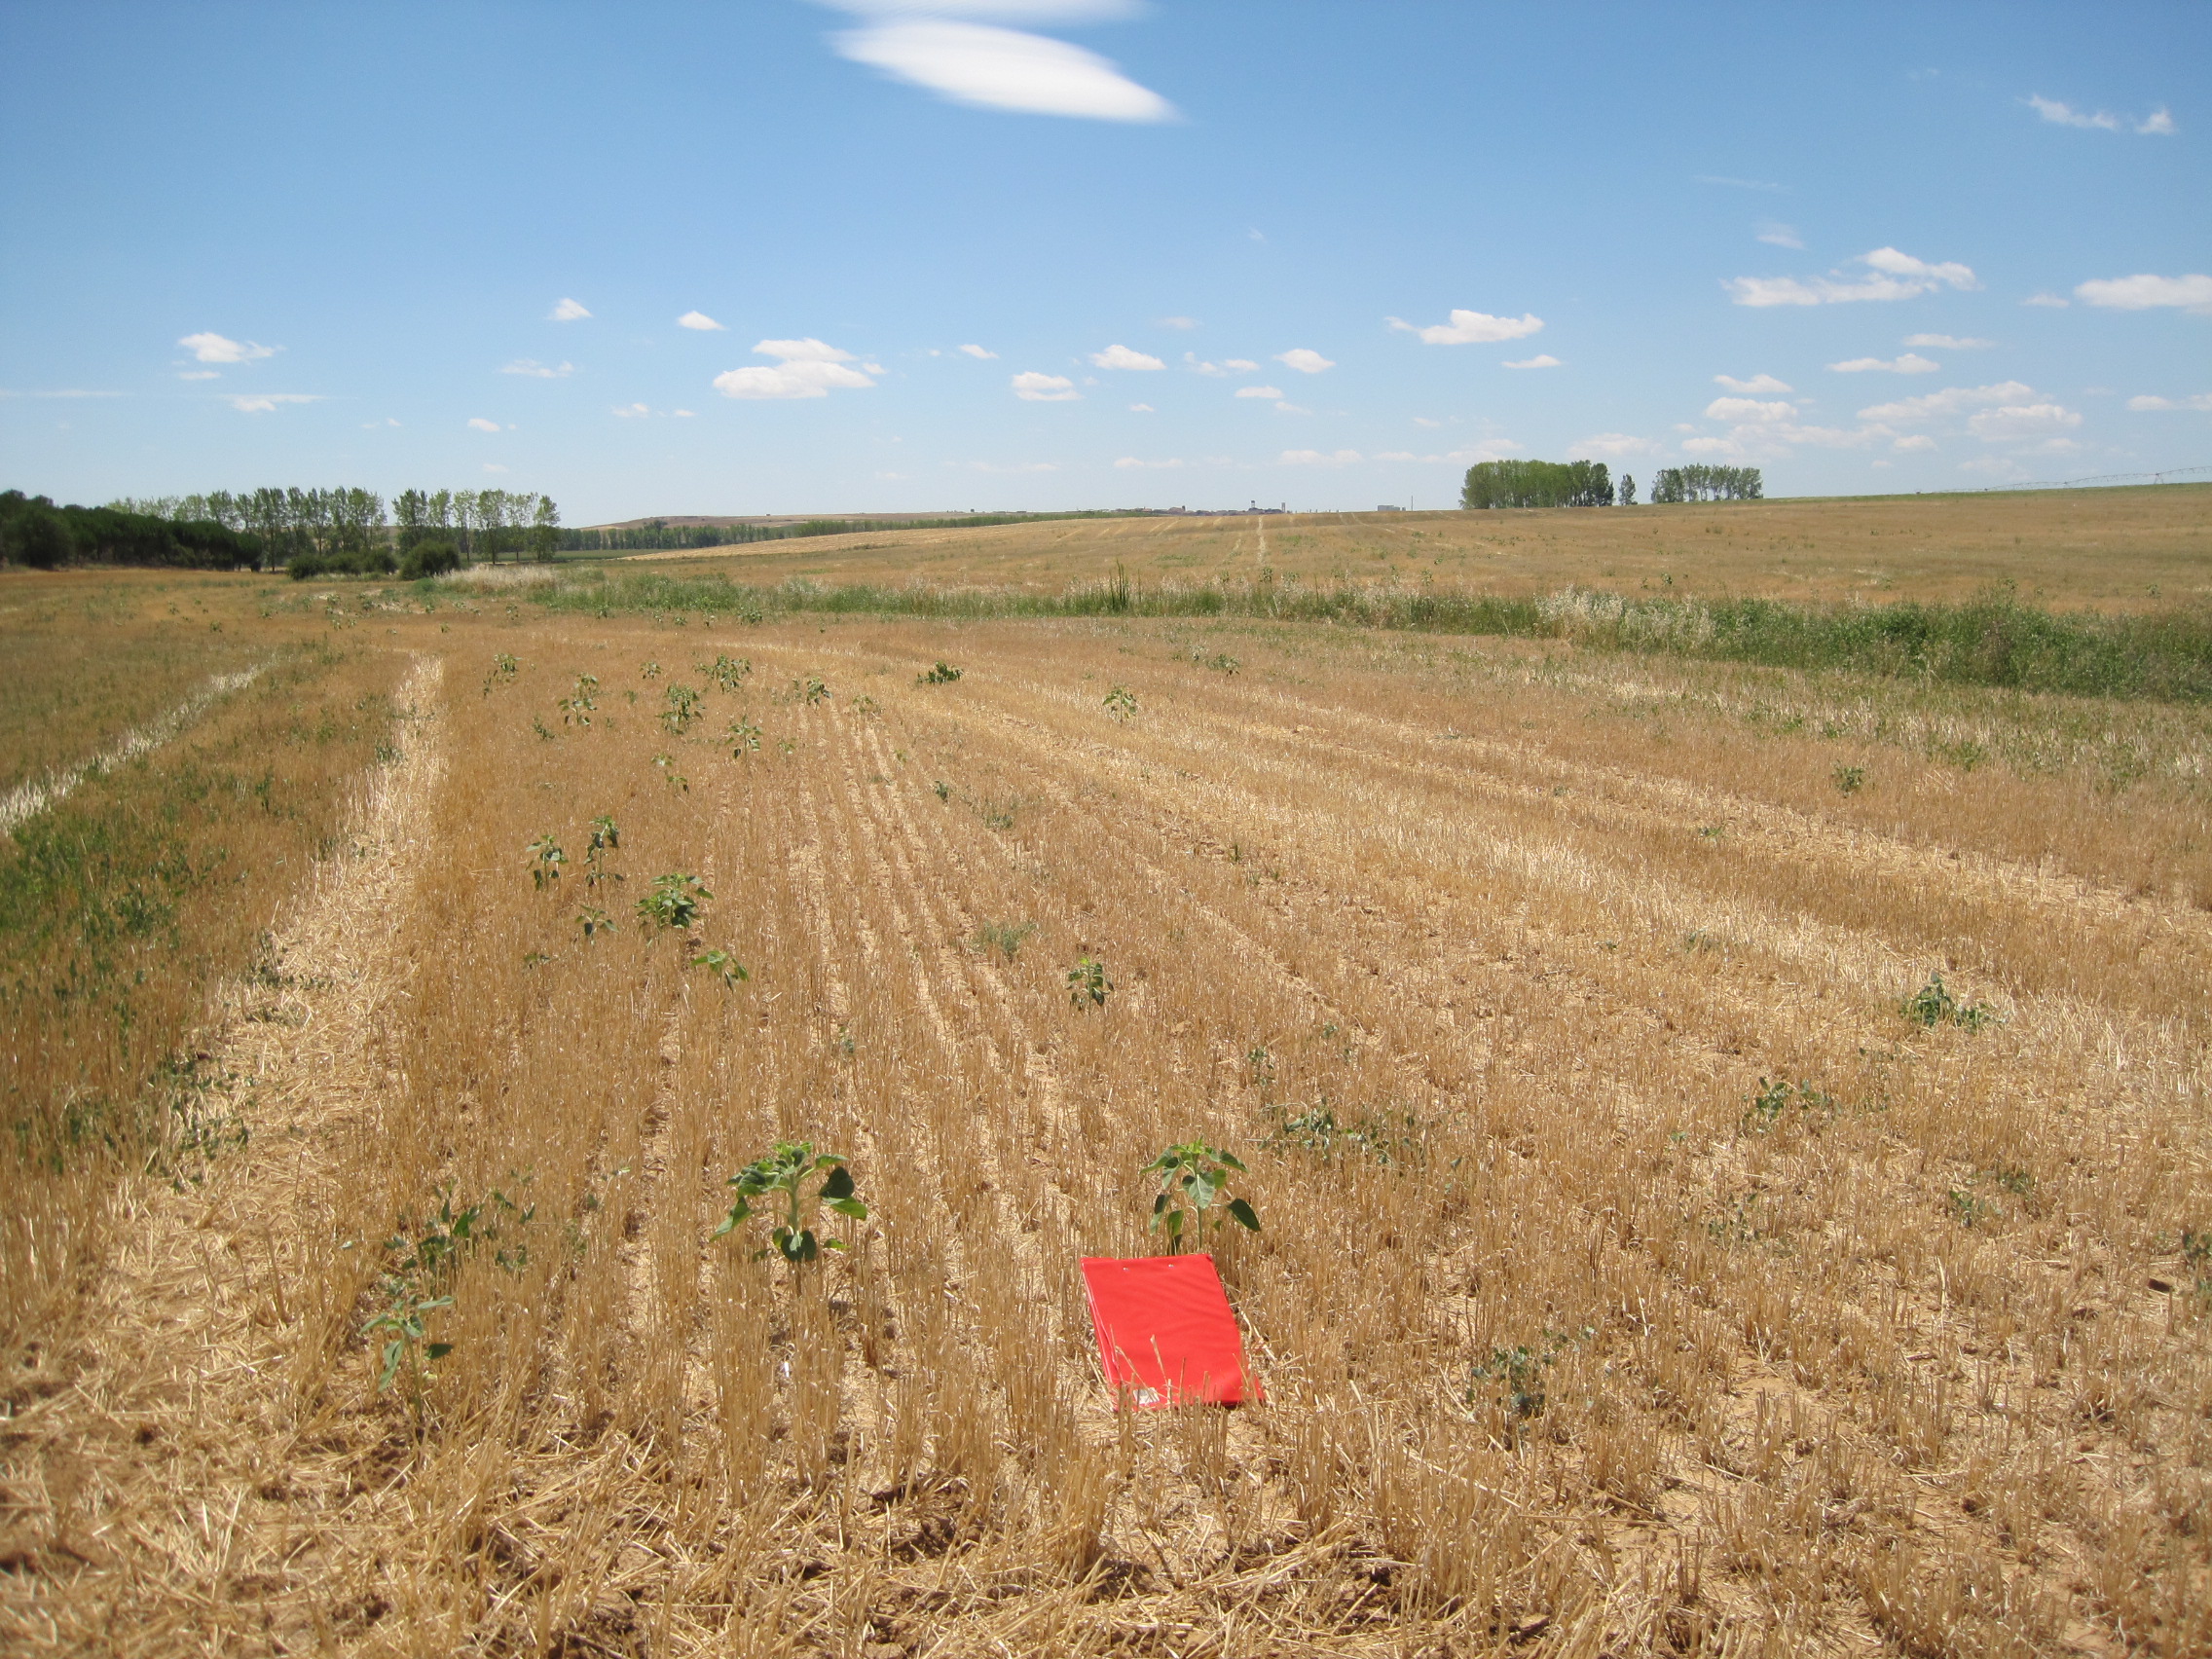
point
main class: Cropland
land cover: Barley
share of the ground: < 10 %
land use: Agriculture (excluding fallow land and kitchen gardens)
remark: Harvested field
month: July
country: ES
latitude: 42.0264
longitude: -5.5860
